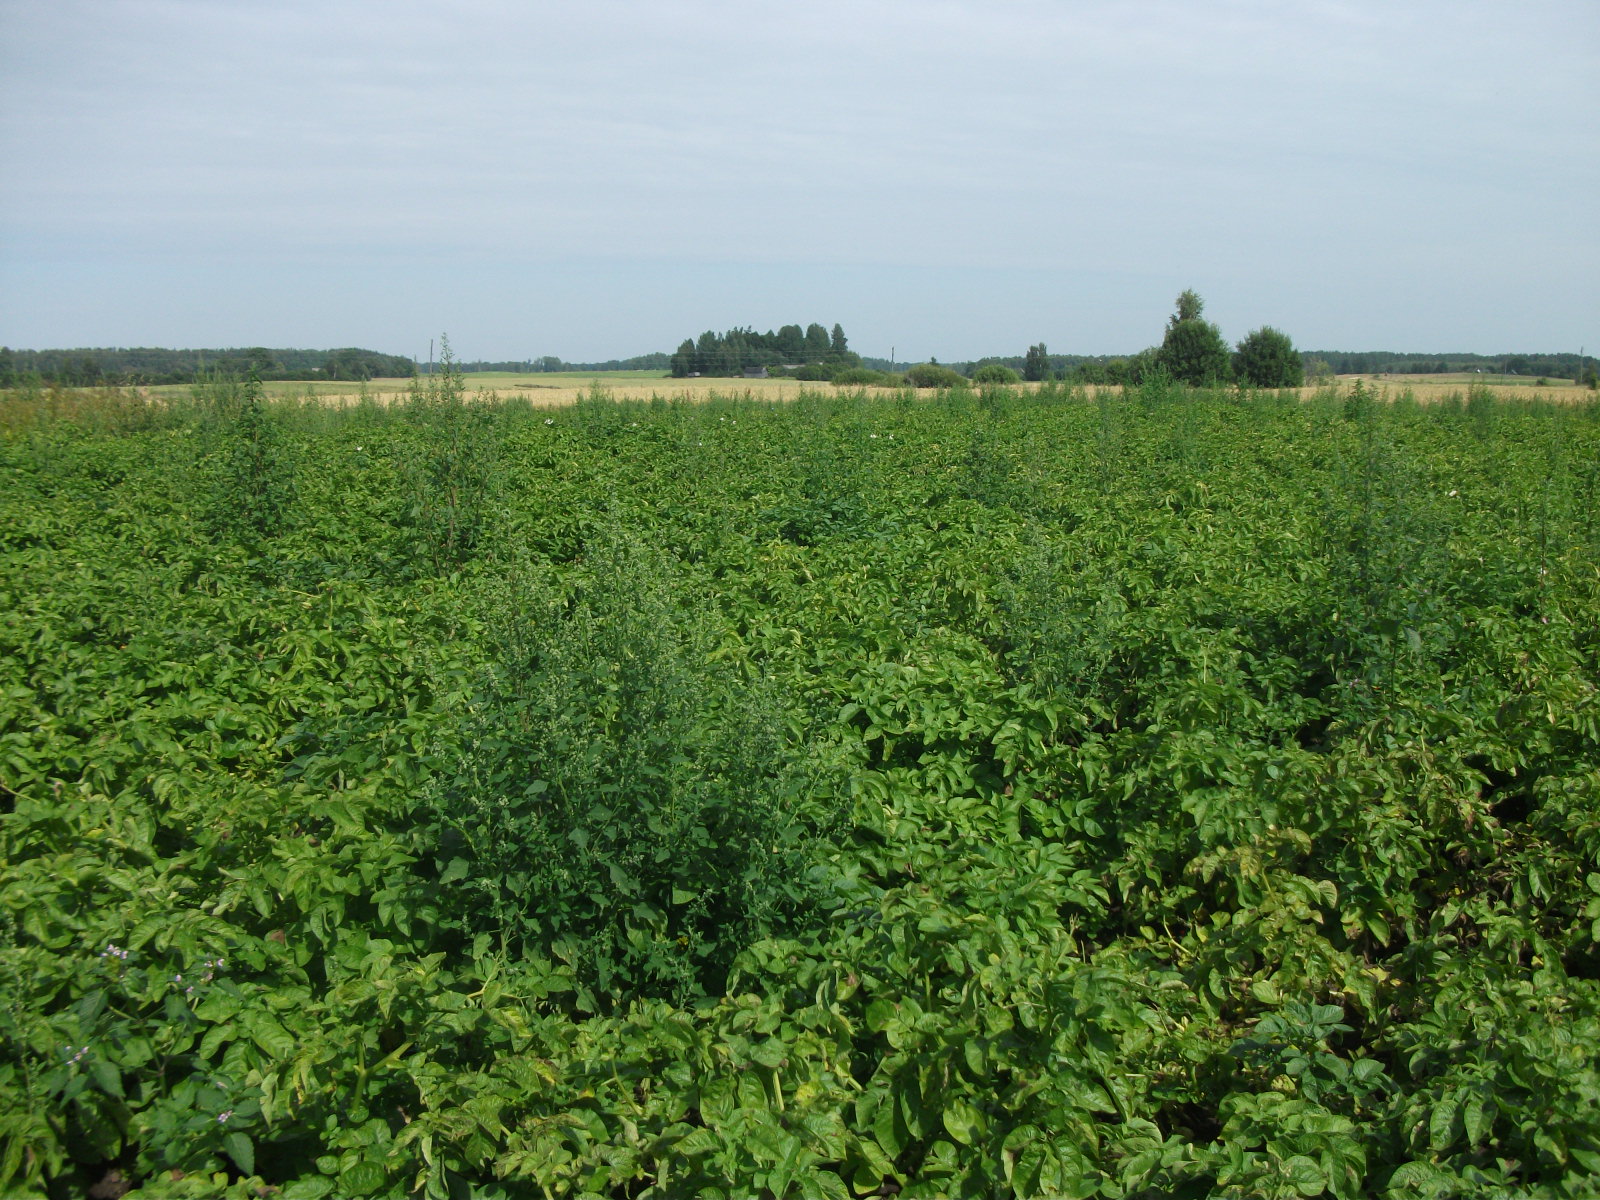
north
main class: Cropland
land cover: Potatoes
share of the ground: > 75 %
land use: Agriculture (excluding fallow land and kitchen gardens)
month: August
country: LV
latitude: 57.1319
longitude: 26.6539
